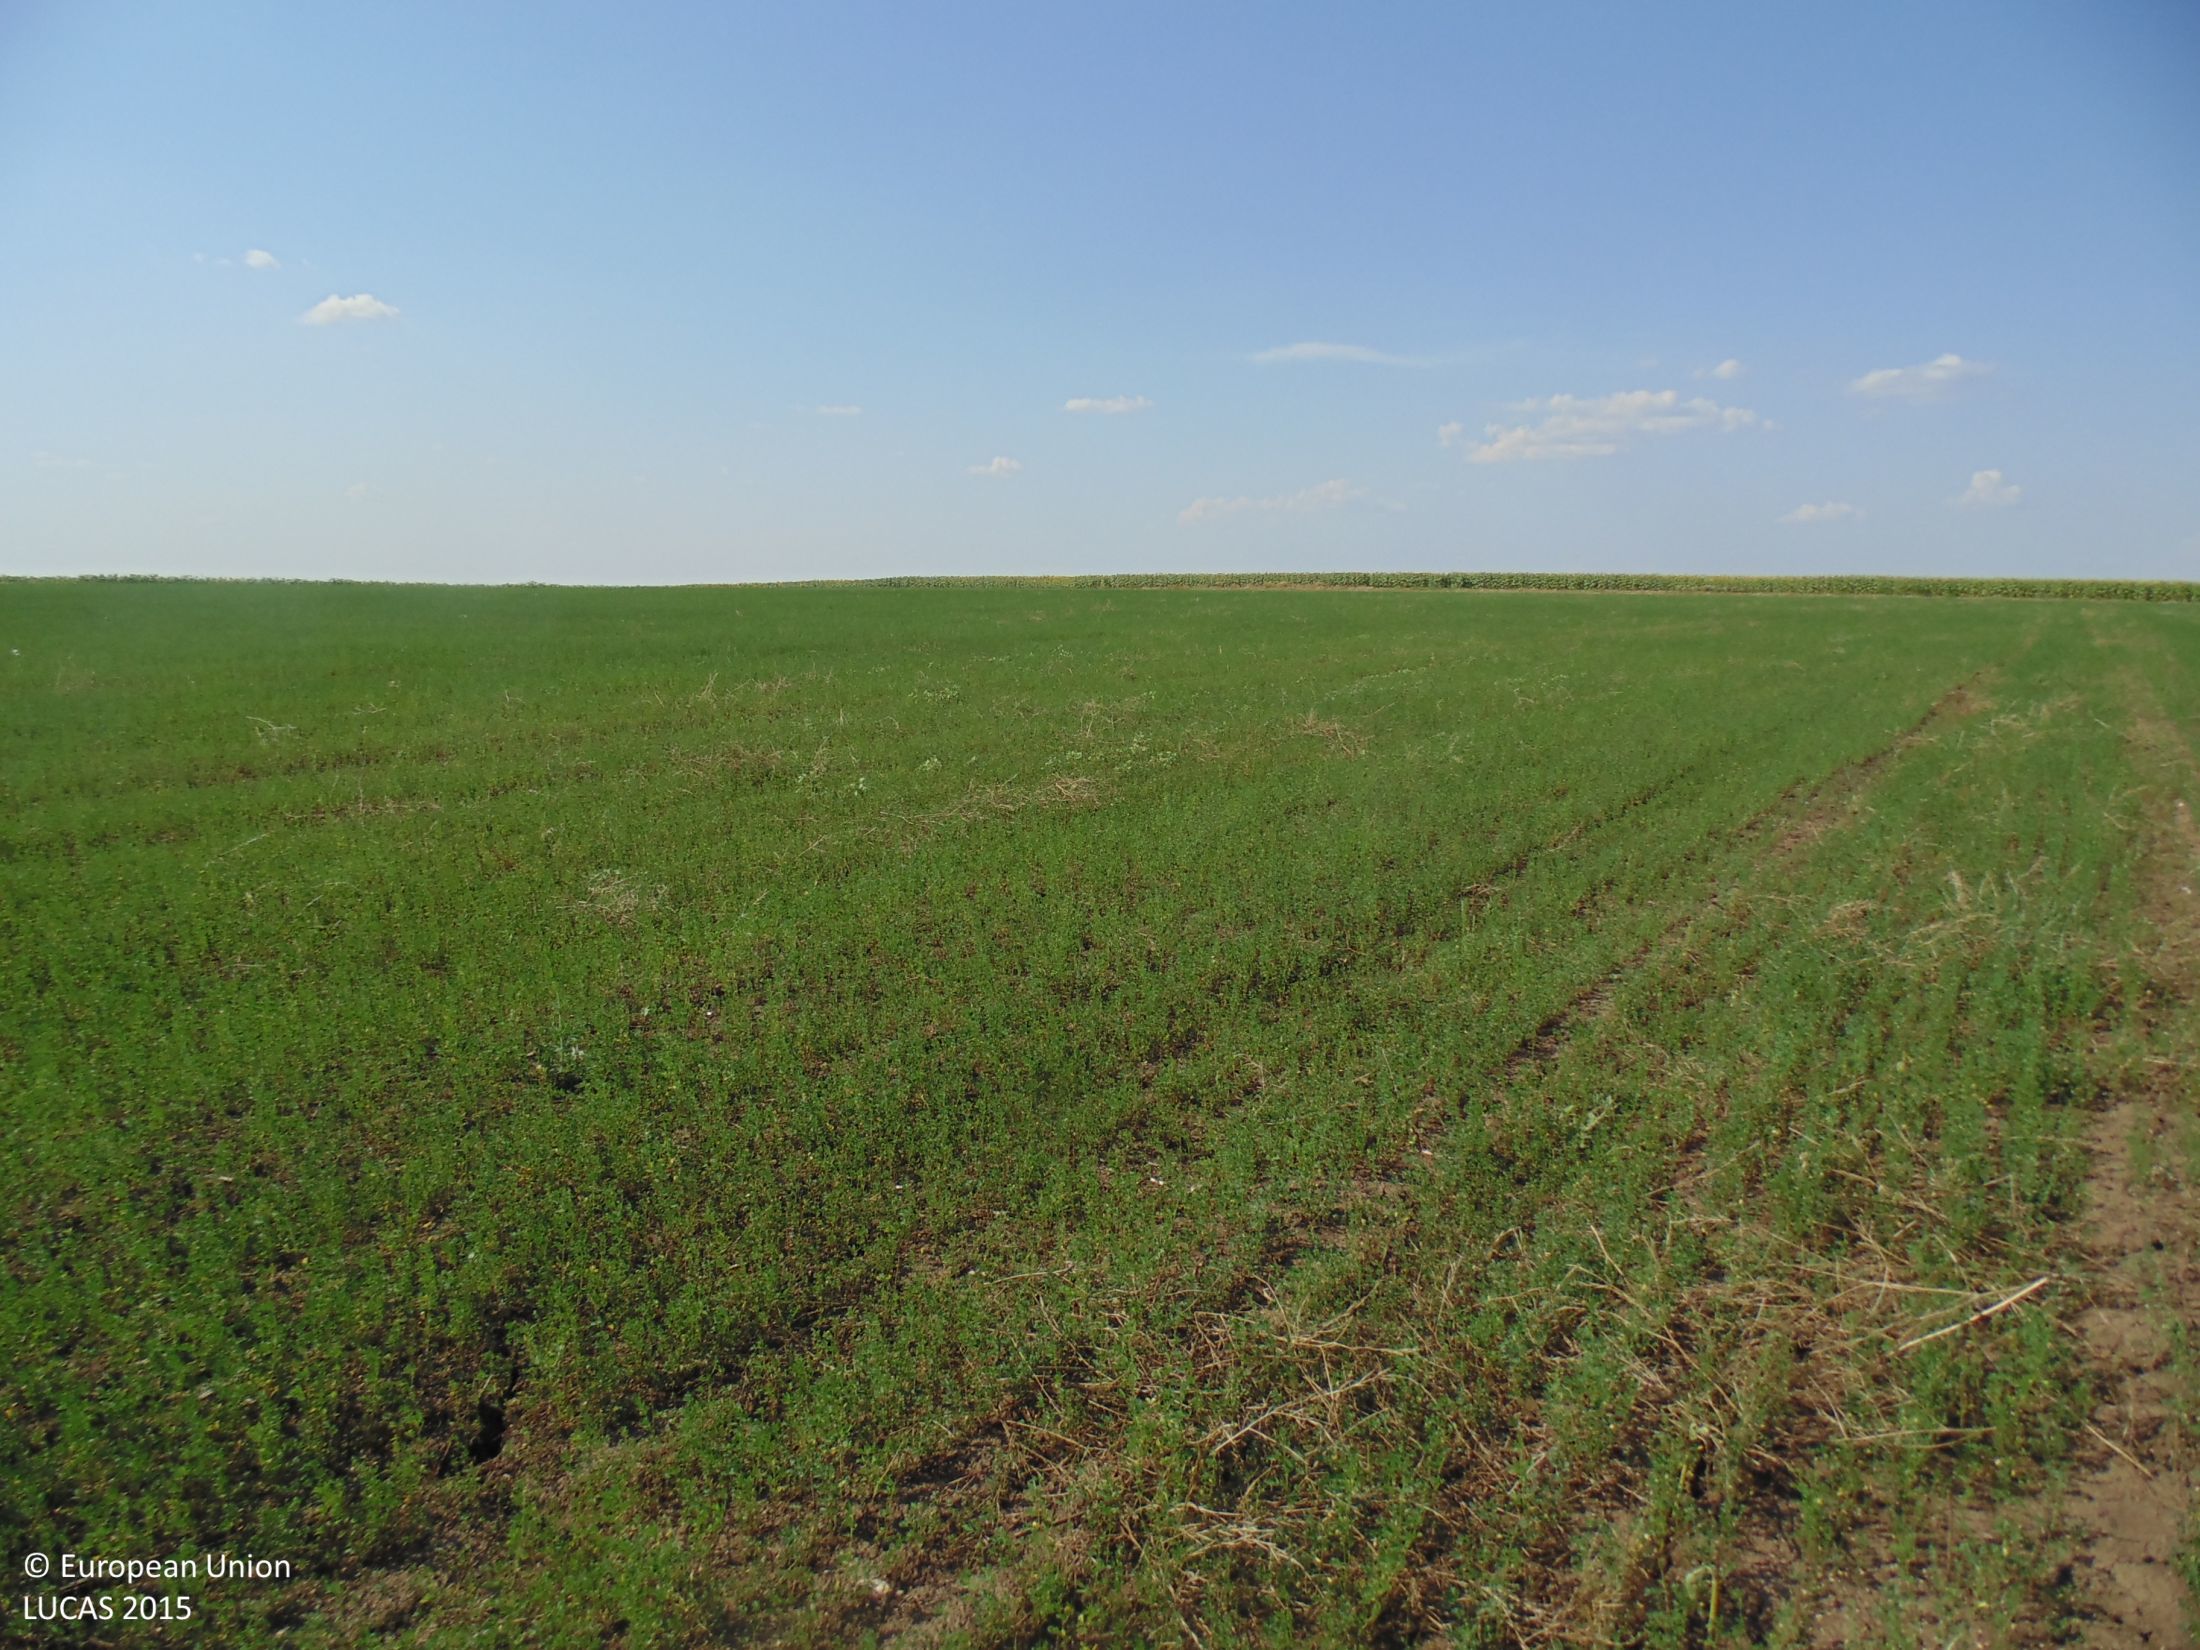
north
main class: Cropland
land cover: Lucerne
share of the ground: > 75 %
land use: Agriculture (excluding fallow land and kitchen gardens)
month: July
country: BG
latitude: 43.6197
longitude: 27.5190
